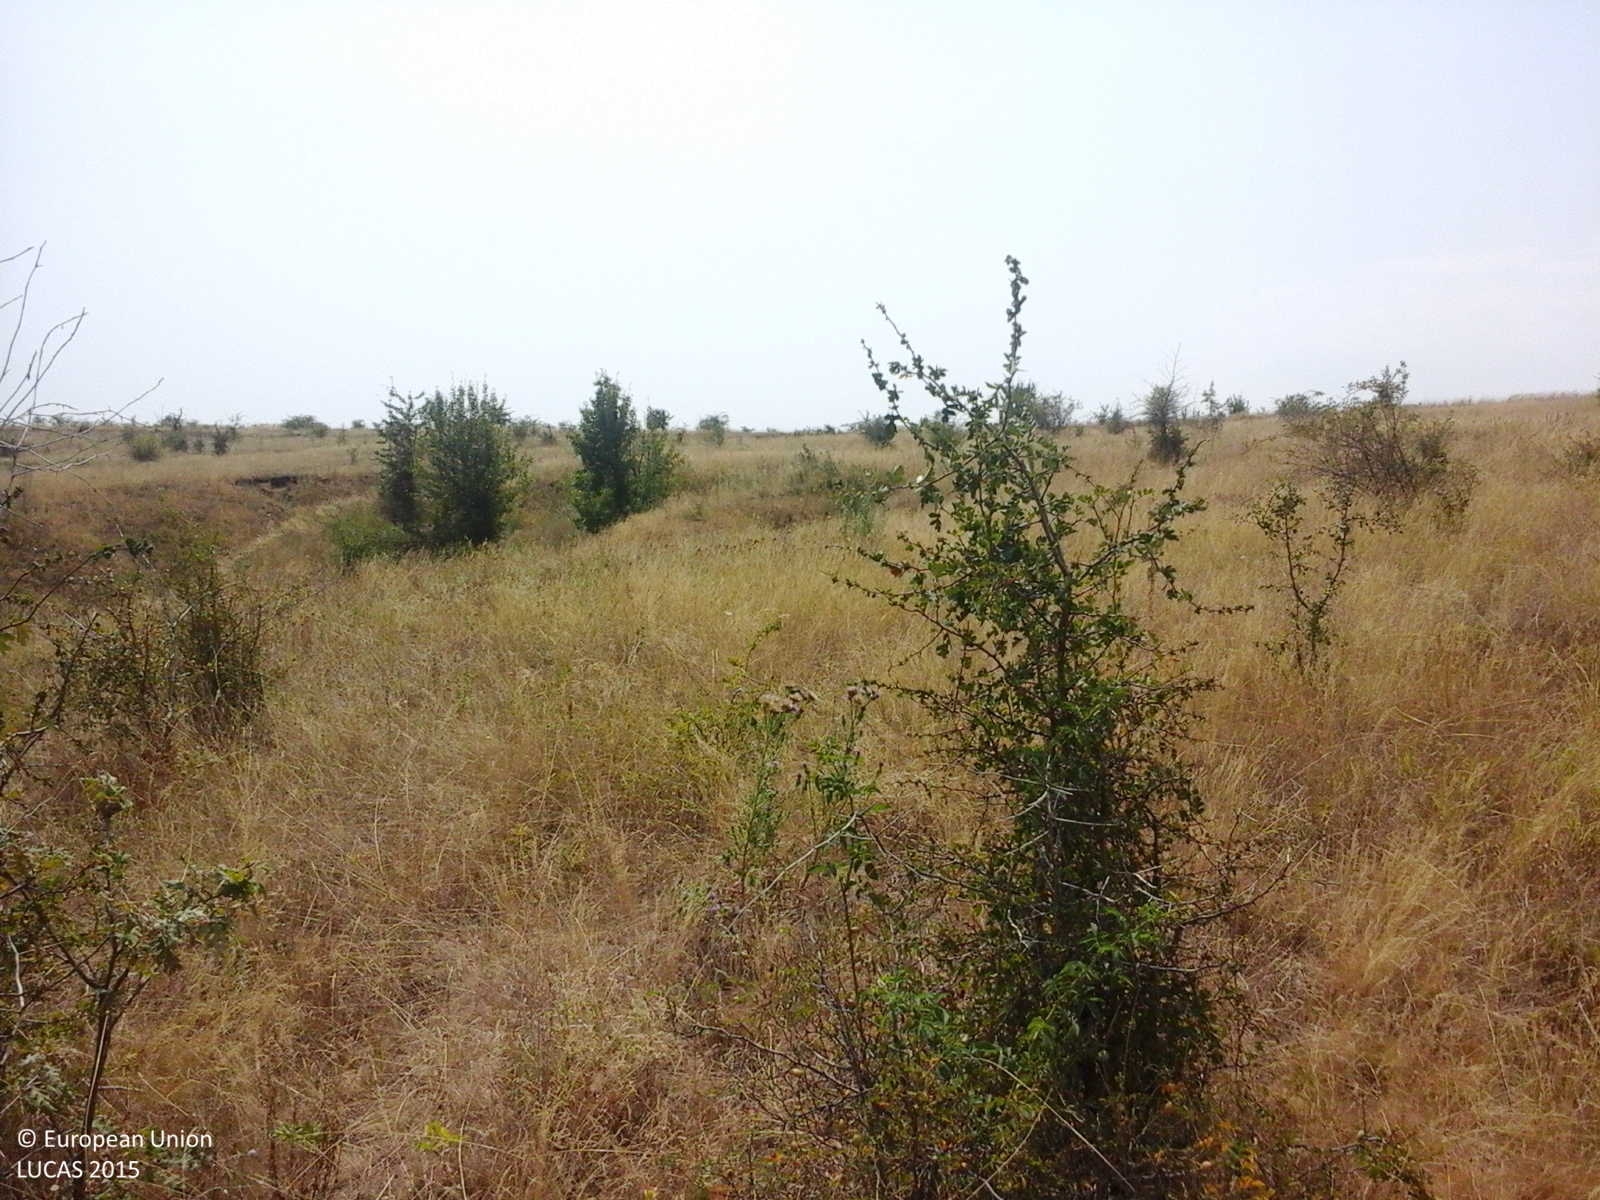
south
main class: Grassland
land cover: Grassland with sparse tree/shrub cover
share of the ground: > 75 %
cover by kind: herbaceous plants 95 %, broadleaved forest trees 5 %
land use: Agriculture (excluding fallow land and kitchen gardens)
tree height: > 5 m
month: August
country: RO
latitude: 44.3617
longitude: 23.3372
